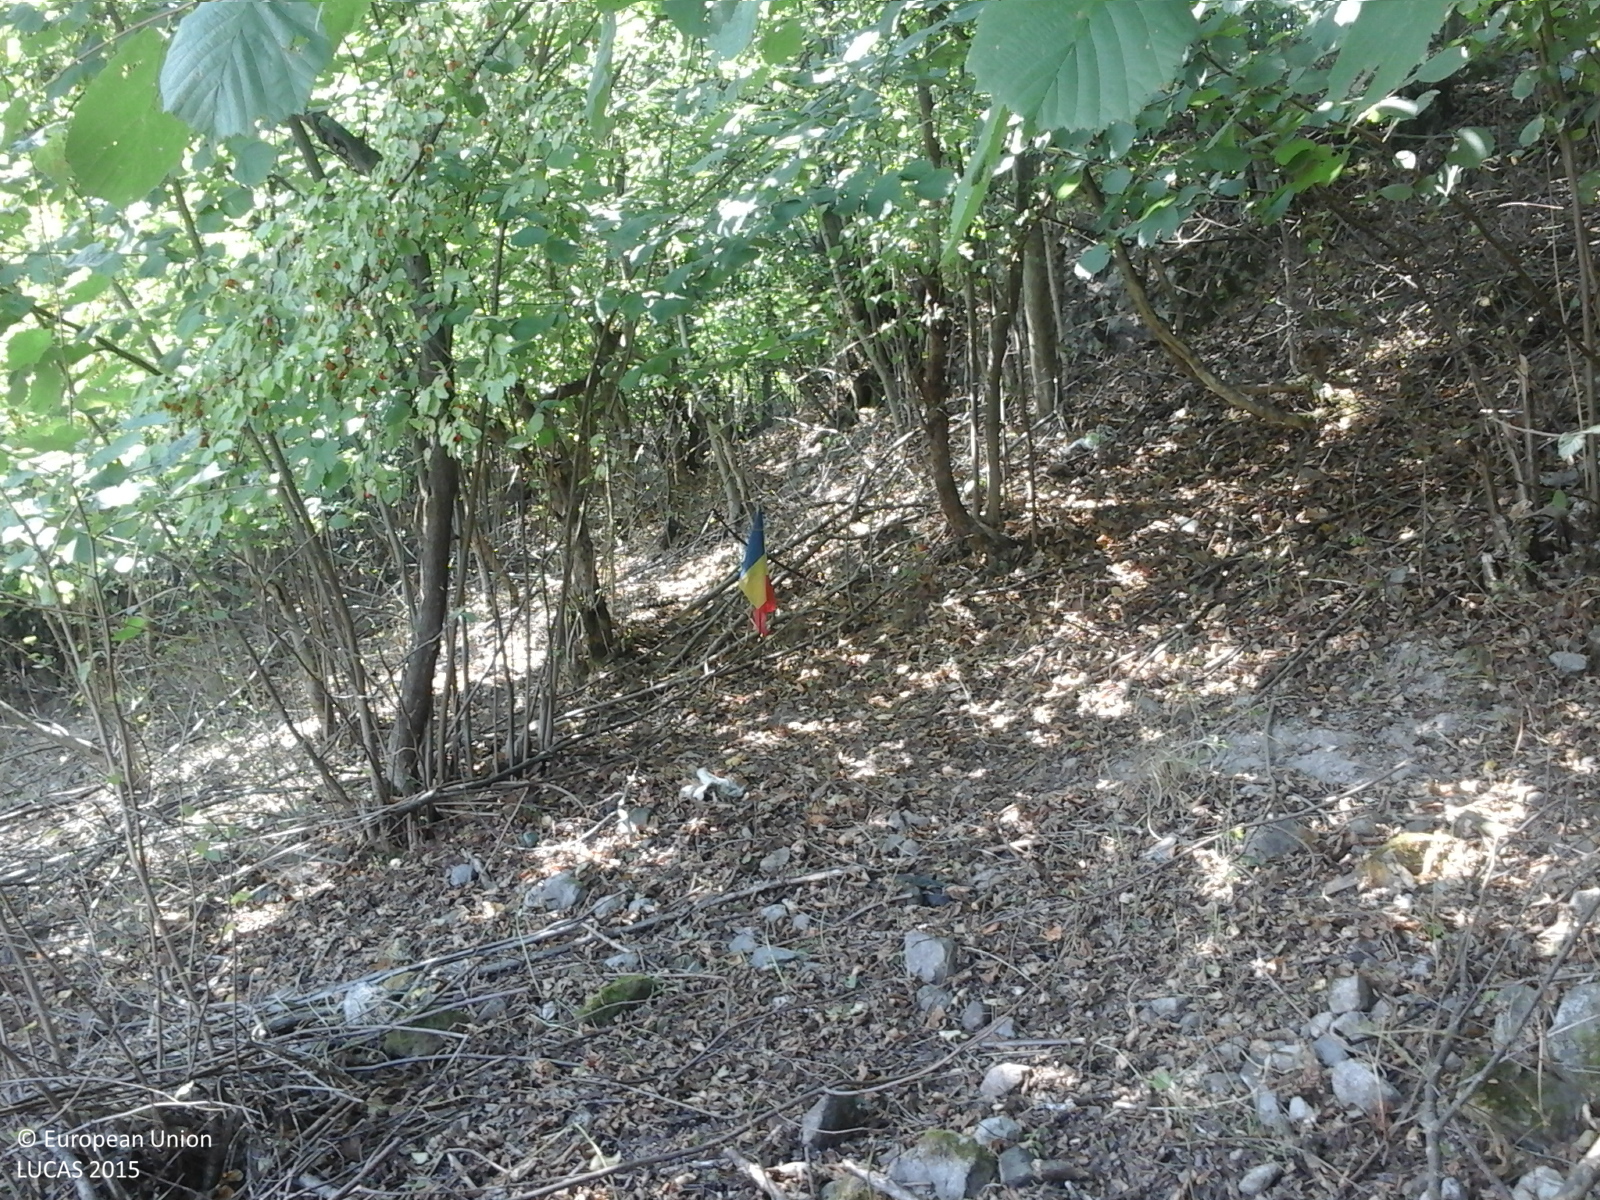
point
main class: Woodland
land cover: Broadleaved woodland
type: broadleaved evergreen forest
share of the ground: > 75 %
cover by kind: broadleaved forest trees 100 %
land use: Forestry
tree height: > 5 m
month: August
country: RO
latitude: 46.1313
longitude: 22.7502
